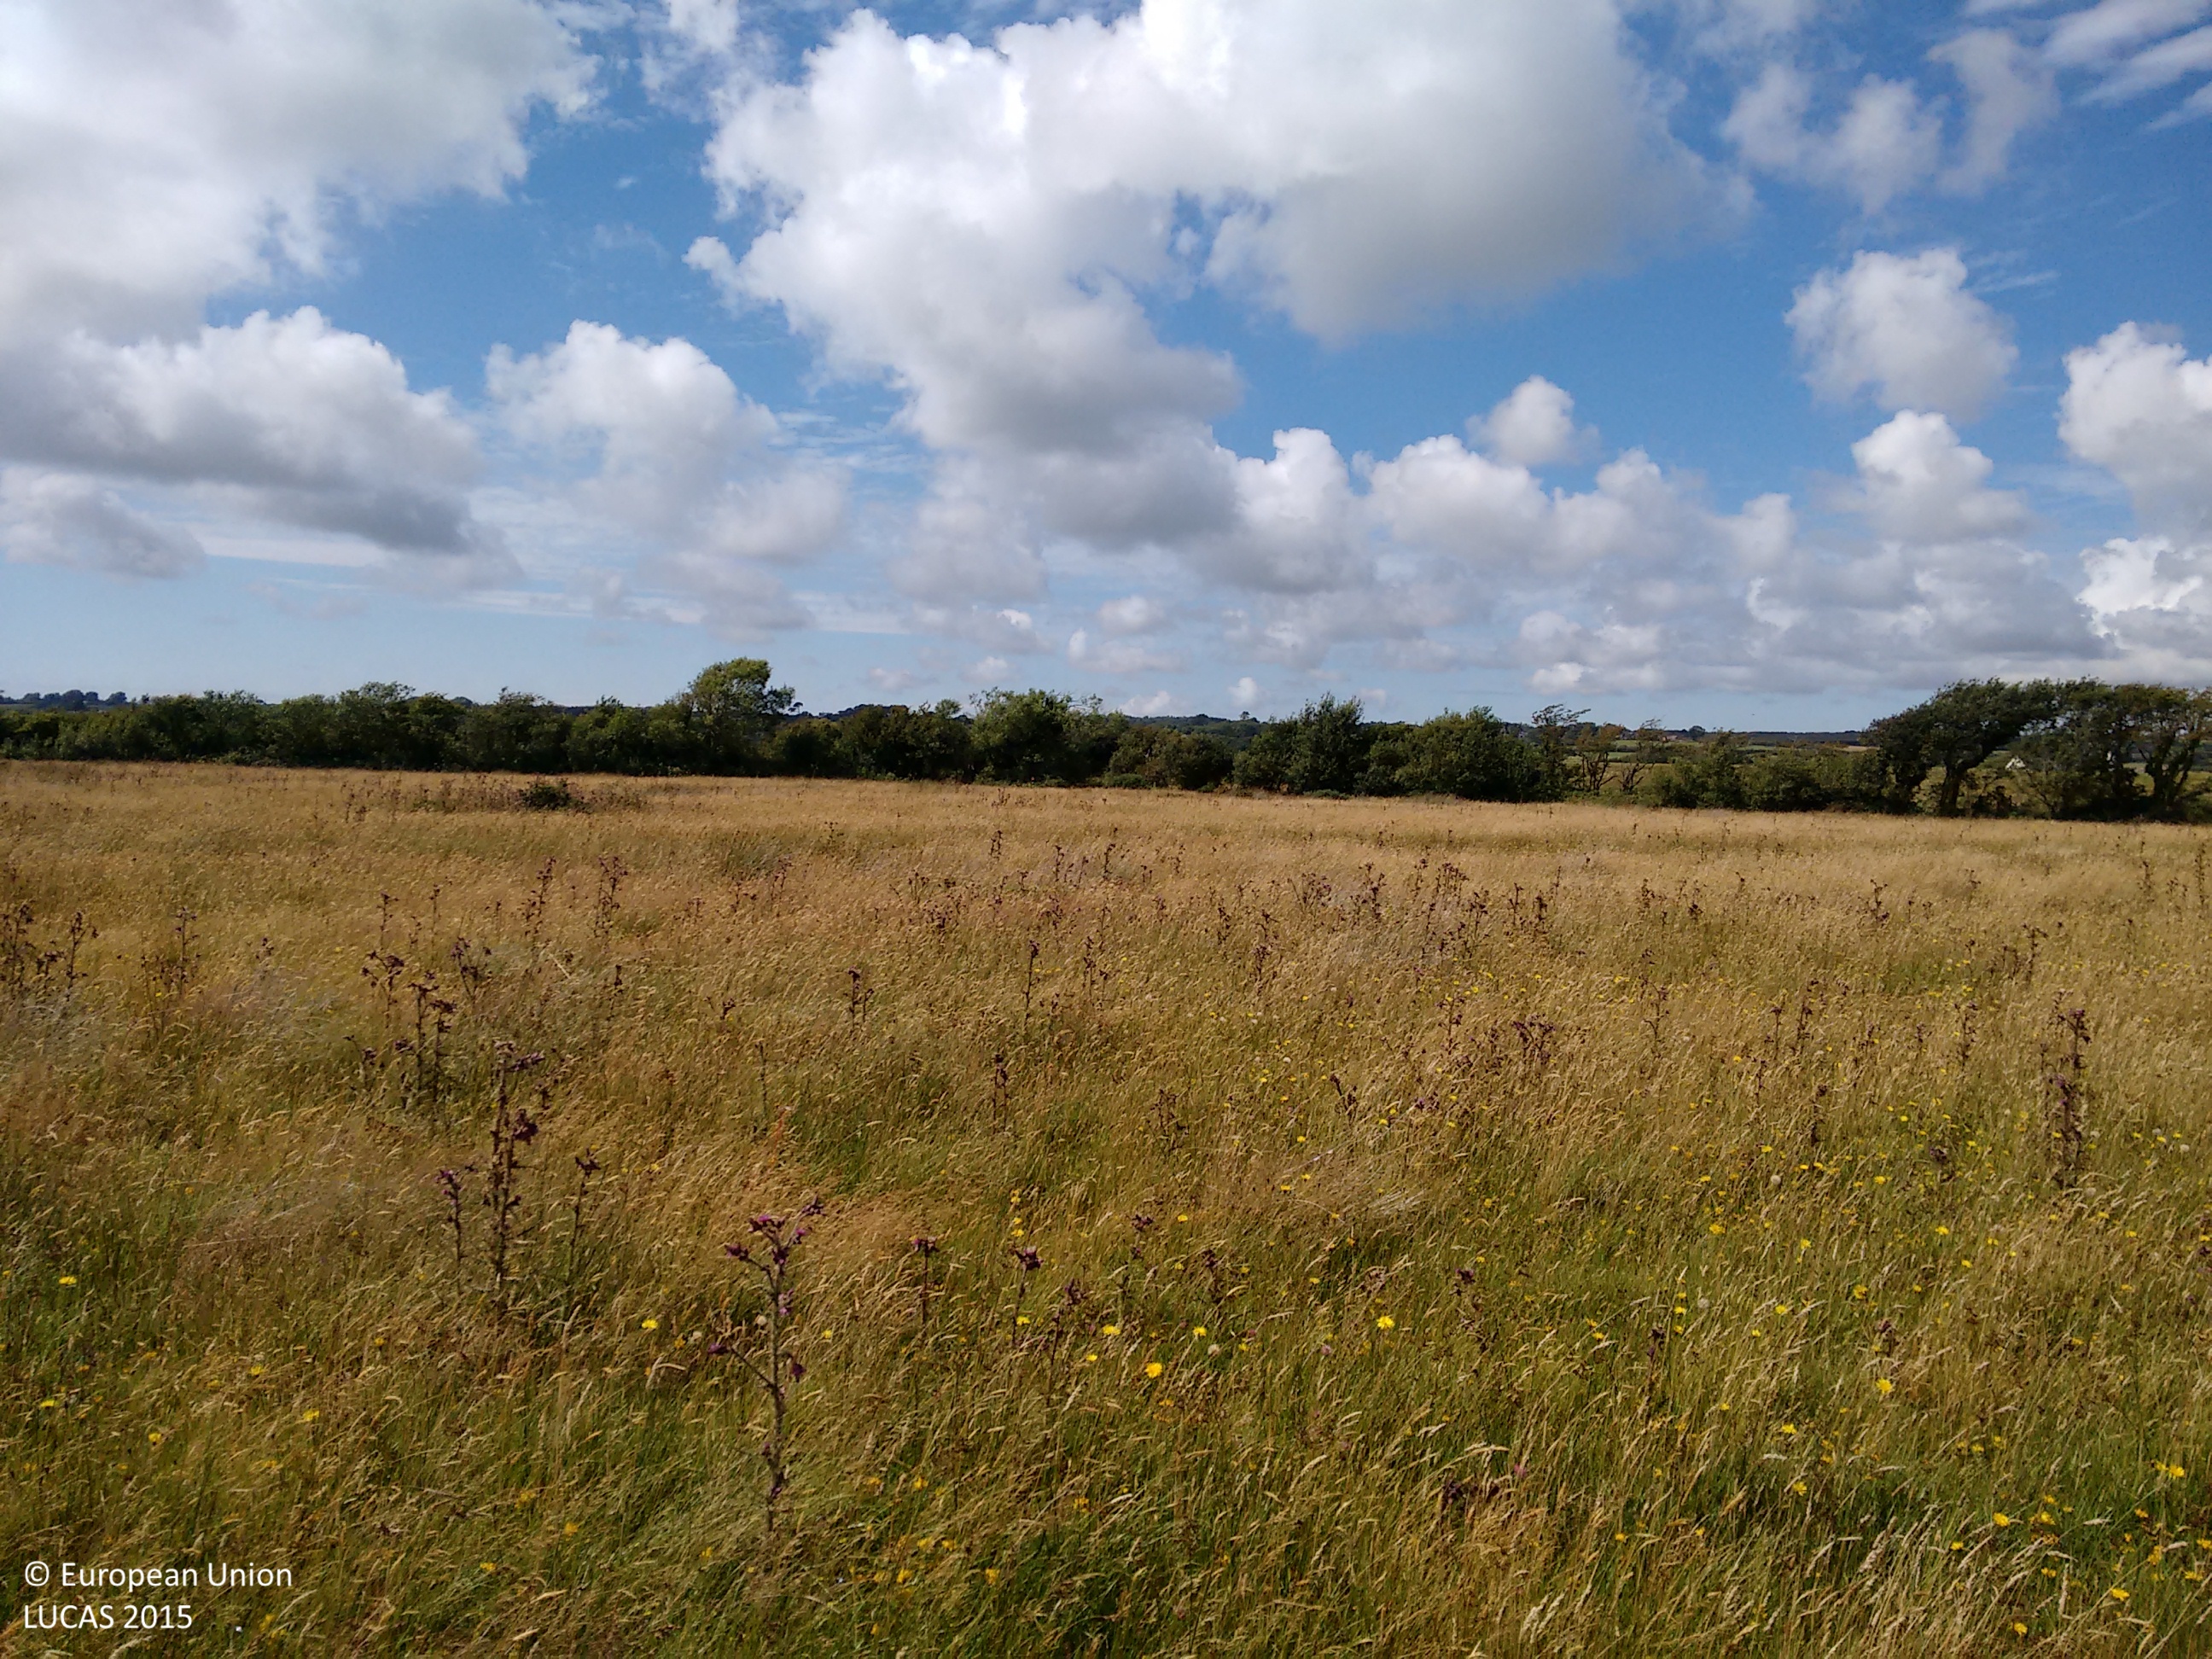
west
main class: Grassland
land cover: Grassland without tree/shrub cover
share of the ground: > 75 %
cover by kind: herbaceous plants 100 %
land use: Agriculture (excluding fallow land and kitchen gardens)
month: August
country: GB
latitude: 53.1970
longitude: -4.3674
